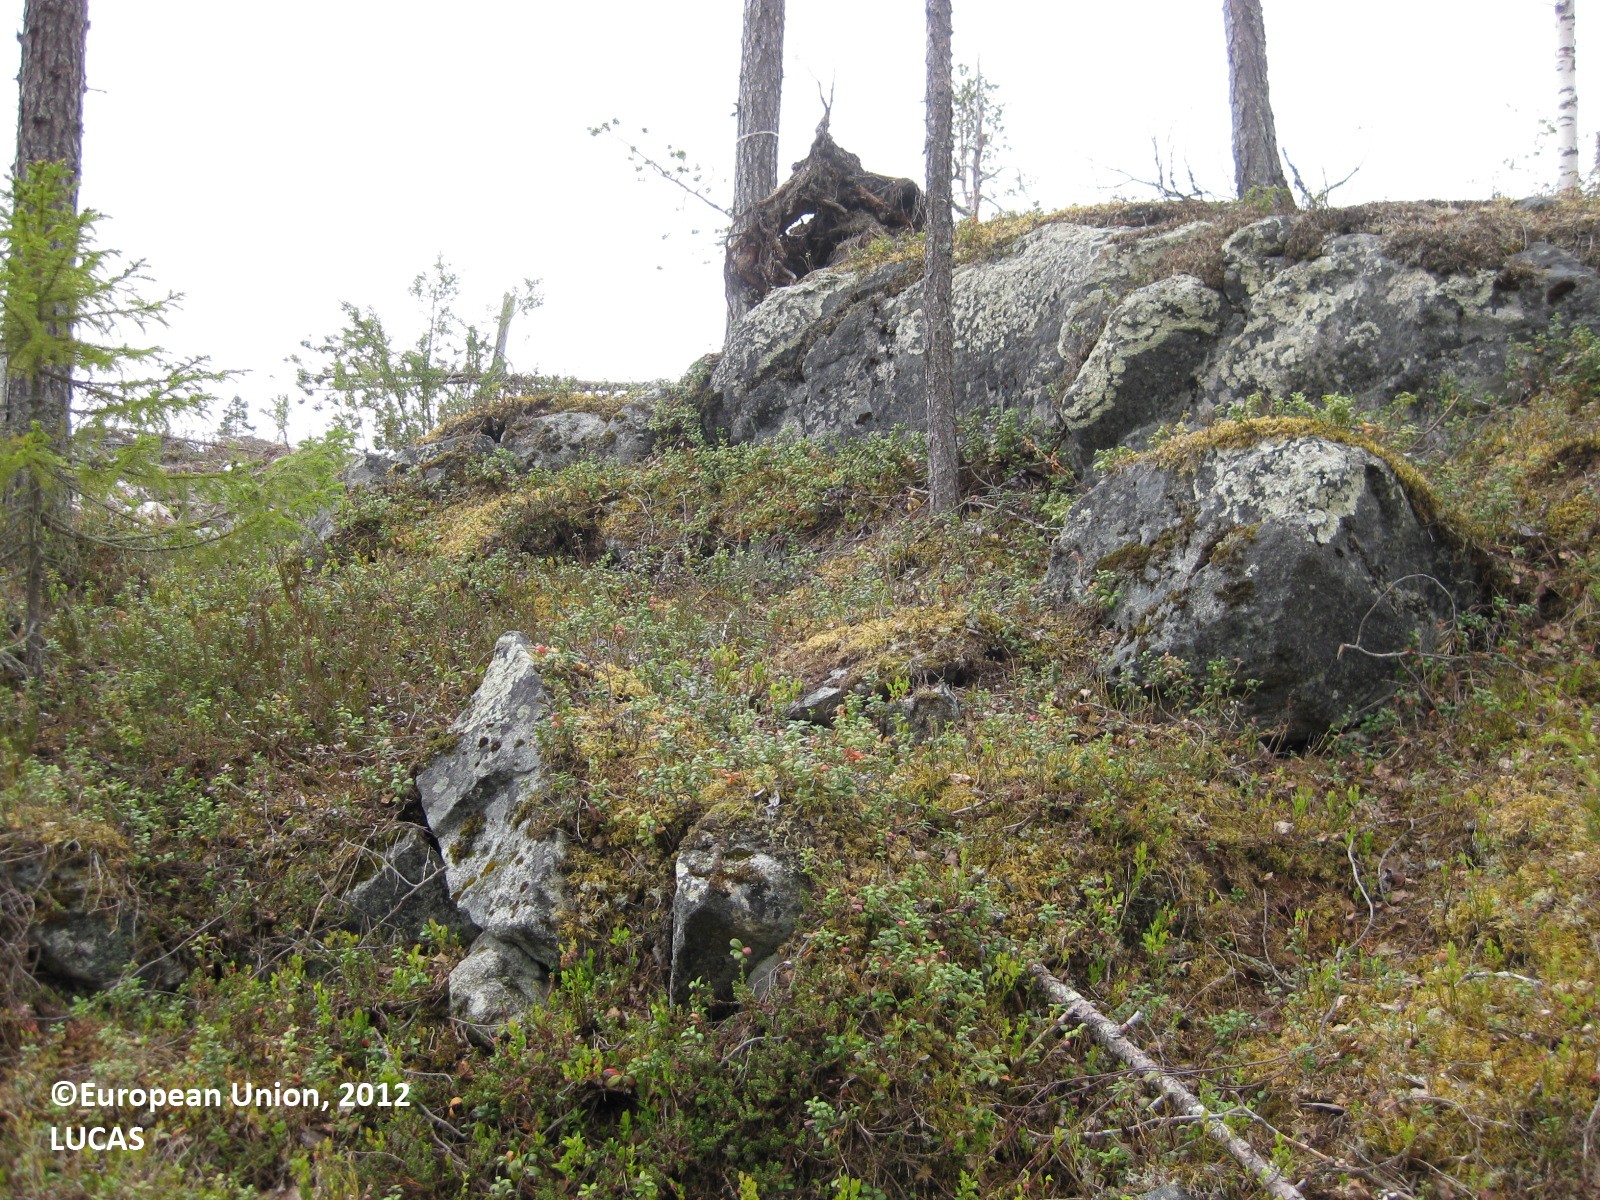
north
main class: Woodland
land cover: Pine dominated mixed woodland
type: boreal forest
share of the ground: 50 - 75 %
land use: Forestry
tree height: > 5 m
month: June
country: FI
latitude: 65.2120
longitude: 29.1944
